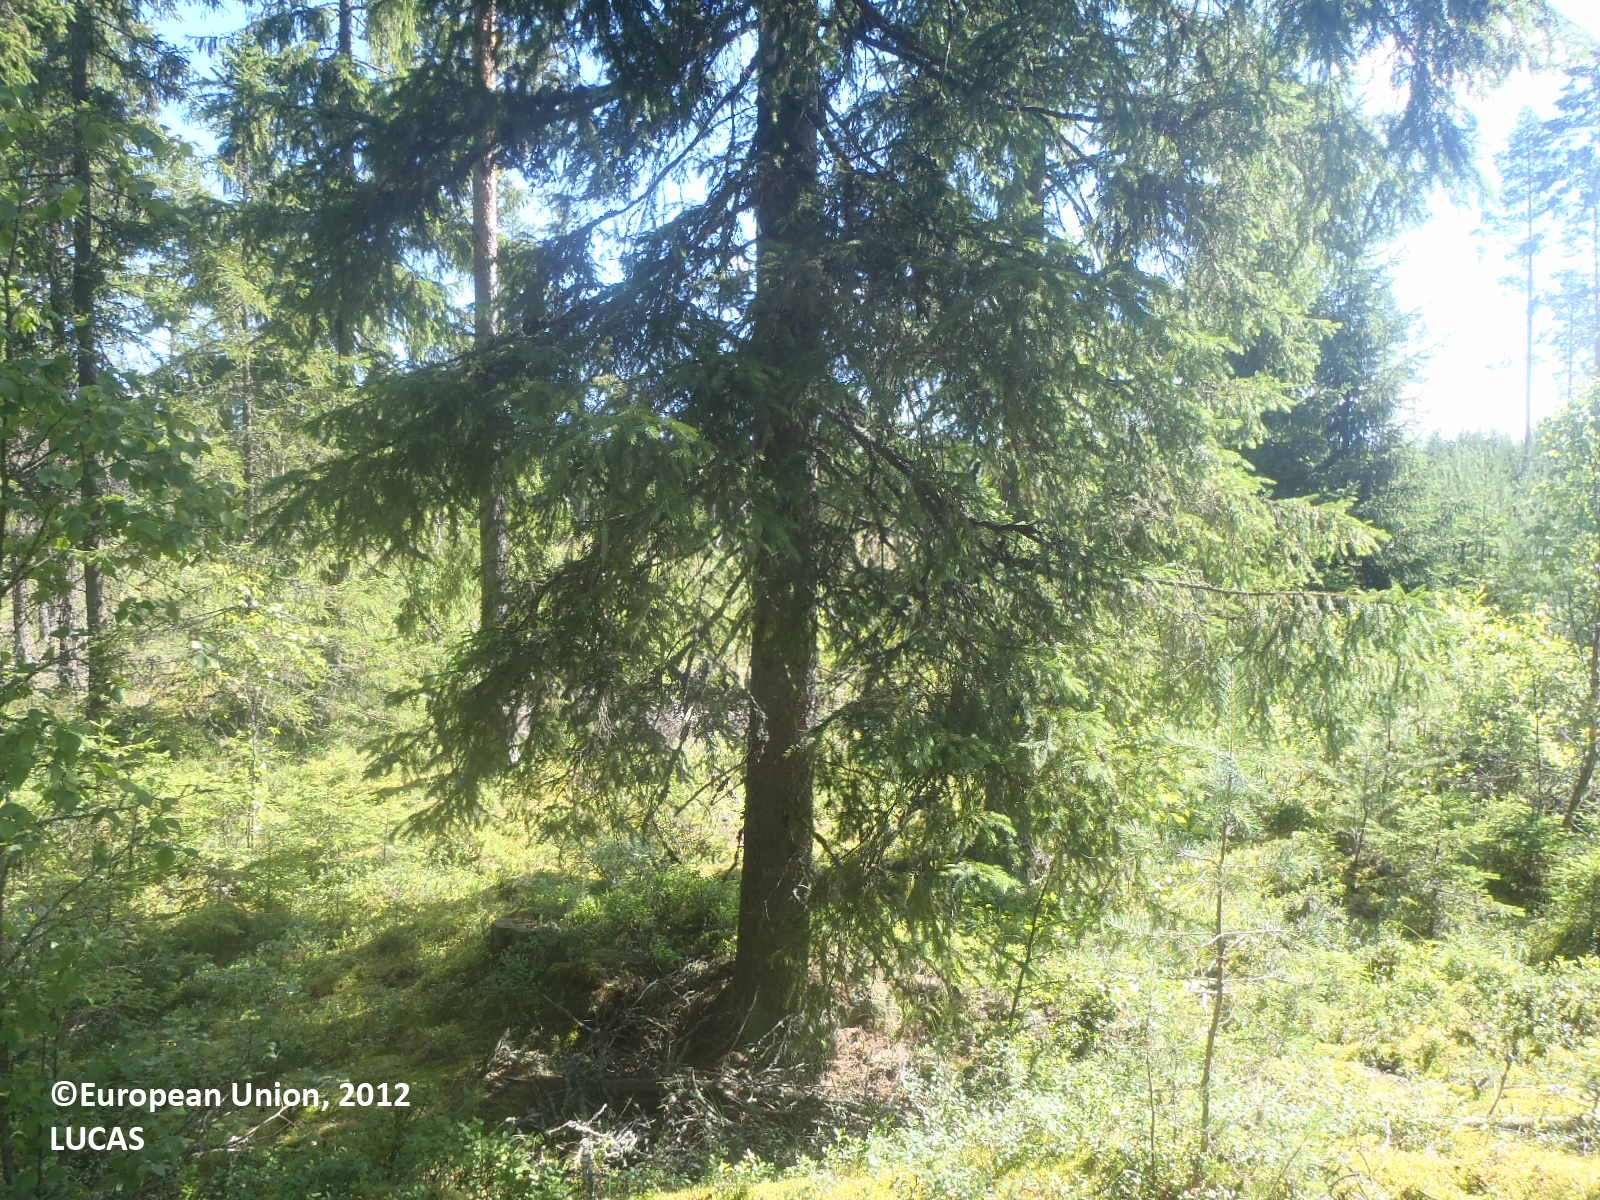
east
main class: Woodland
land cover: Spruce dominated coniferous woodland
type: boreal forest
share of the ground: 50 - 75 %
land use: Forestry
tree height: > 5 m
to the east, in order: Spruce dominated coniferous woodland; Grassland with sparse tree/shrub cover; Ditches and canals; Other mixed woodland; Ditches and canals; Other mixed woodland; Pine dominated coniferous woodland
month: July
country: FI
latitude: 61.0291
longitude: 21.8472
